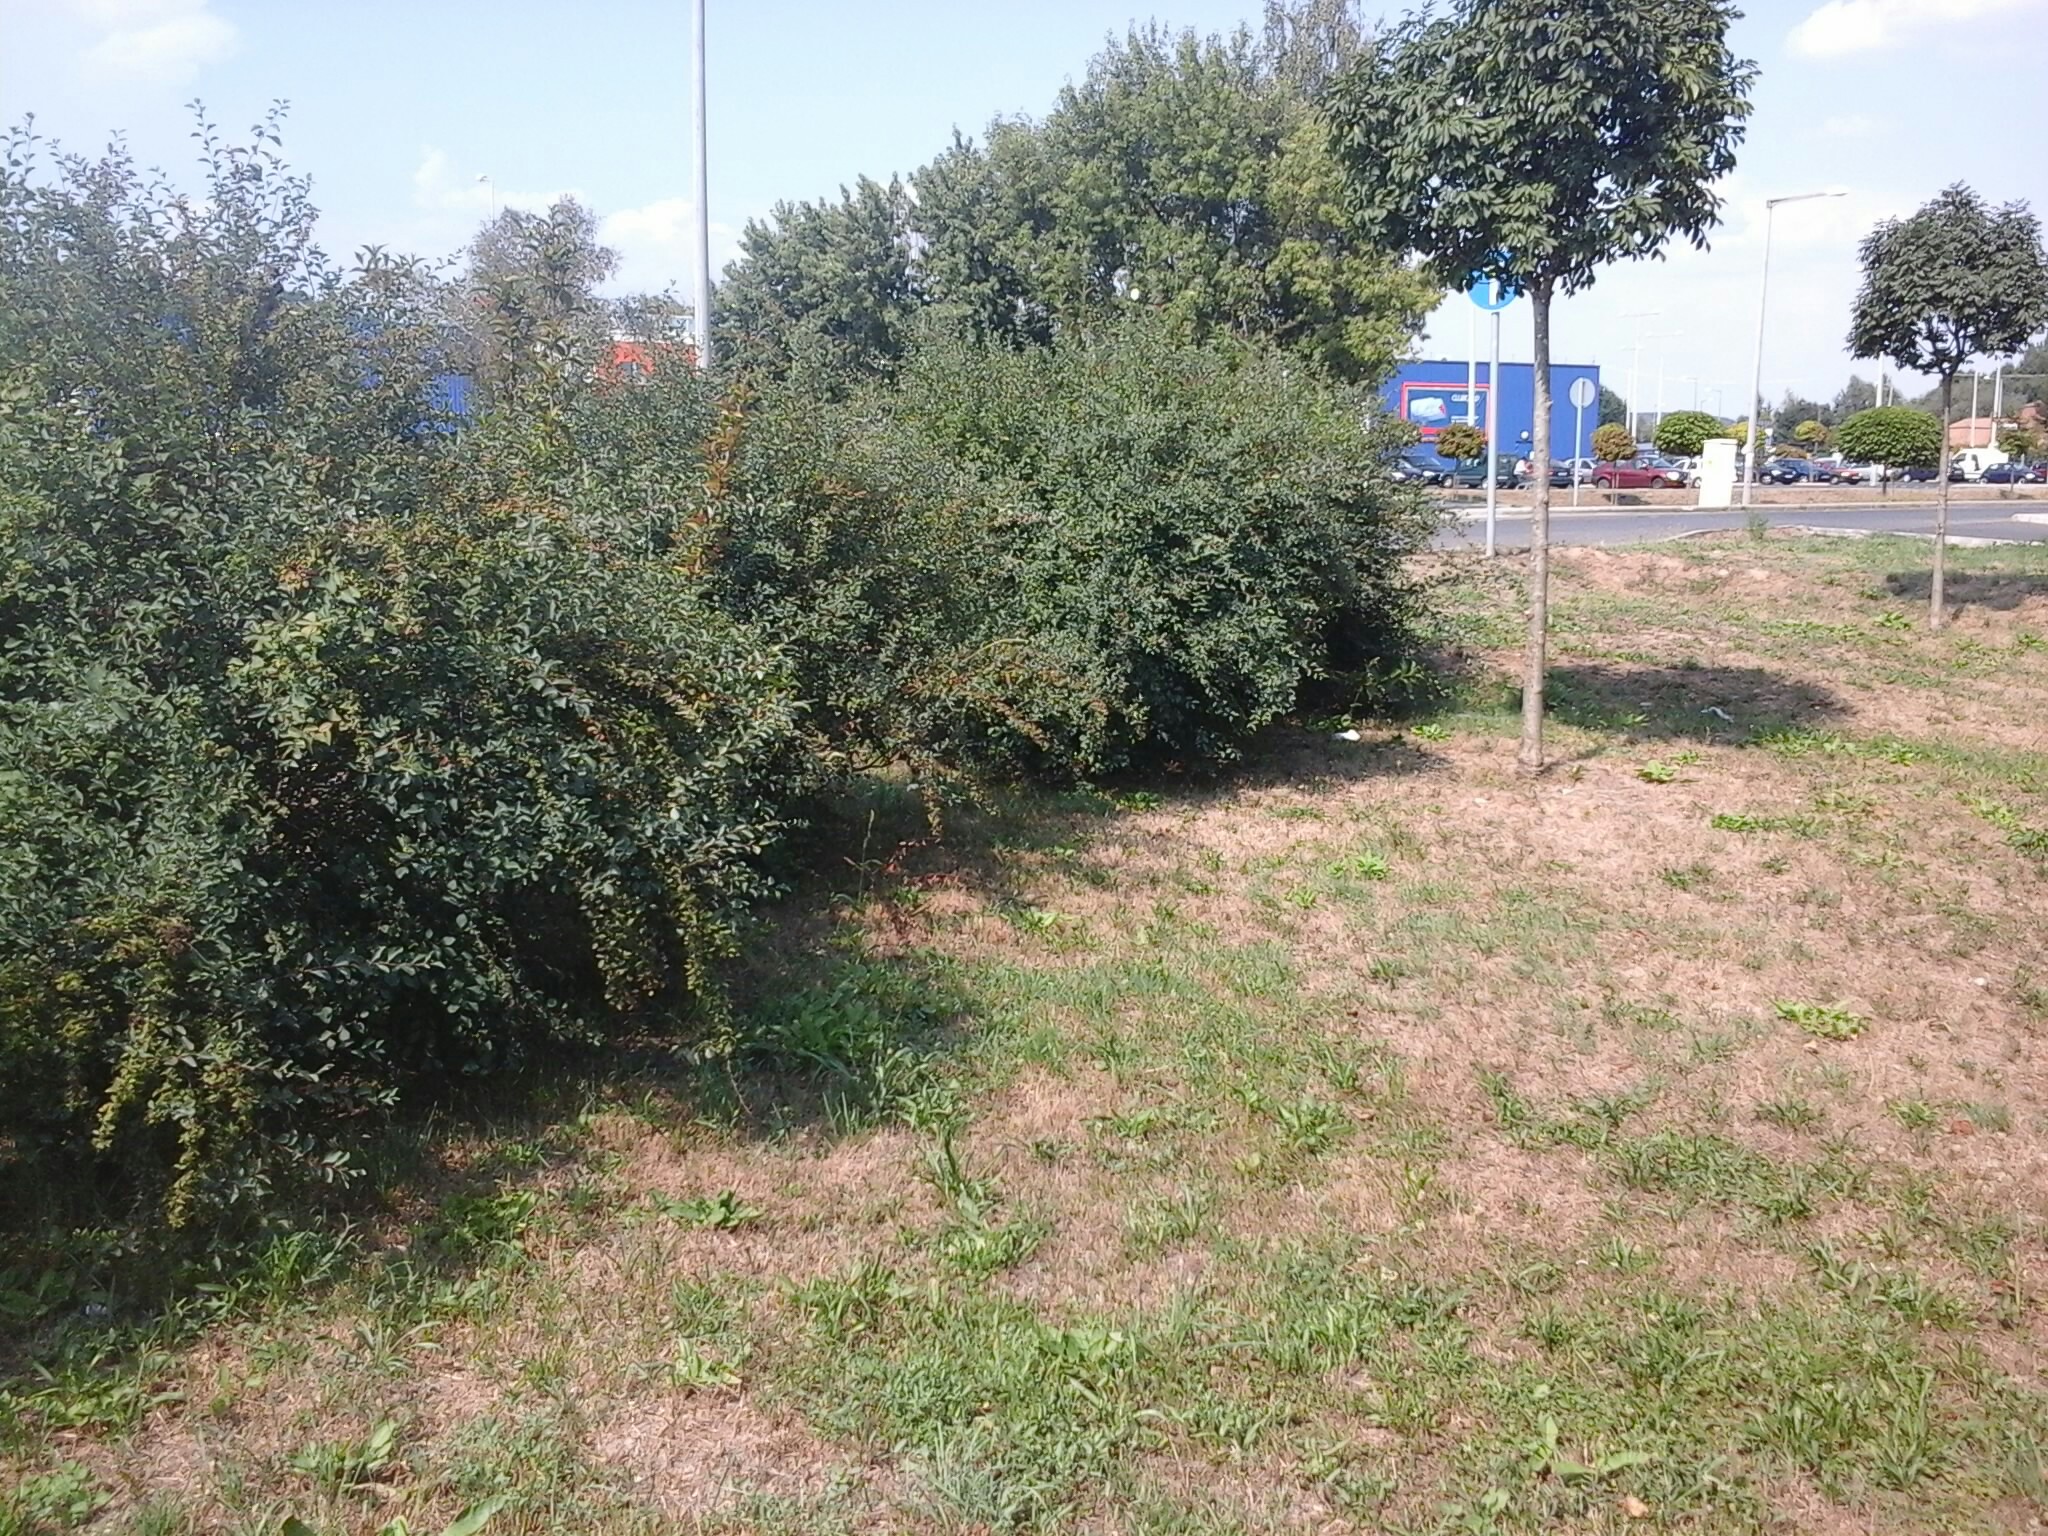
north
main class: Cropland
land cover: Vineyards
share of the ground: 10 - 25 %
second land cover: Grassland without tree/shrub cover
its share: 50 - 75 %
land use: Kitchen garden
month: August
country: HU
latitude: 48.0834
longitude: 19.2980
